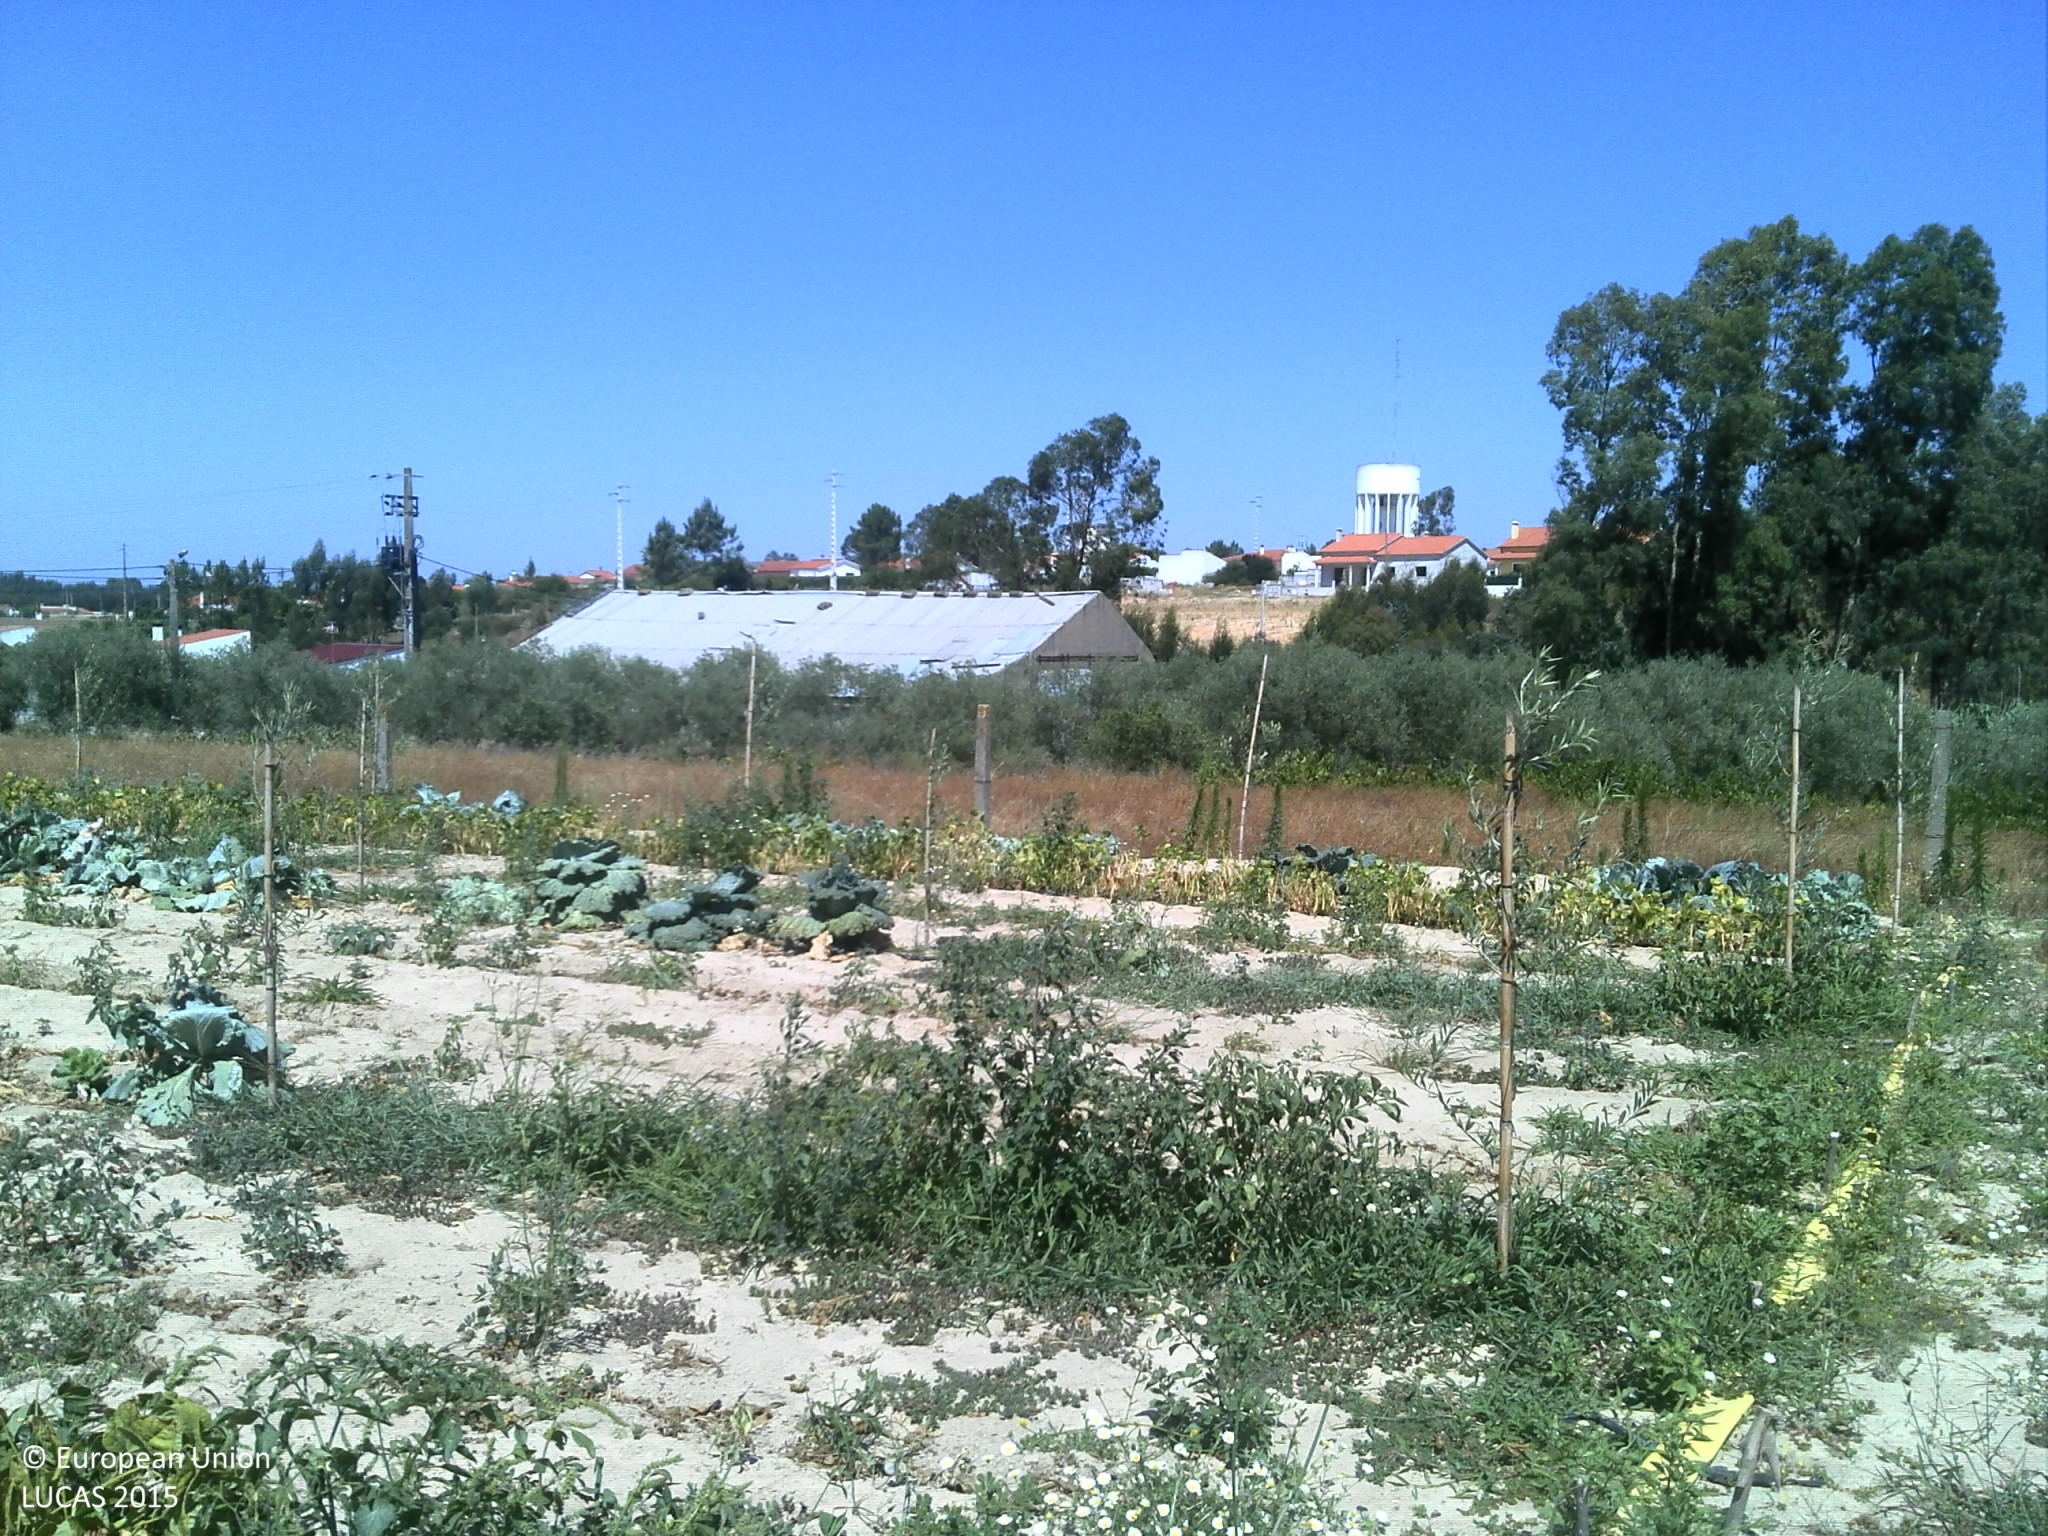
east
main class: Cropland
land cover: Oranges
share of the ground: 50 - 75 %
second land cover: Other bare soil
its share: > 75 %
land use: Agriculture (excluding fallow land and kitchen gardens)
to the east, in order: Fences; Olive groves; Other fresh vegetables; Fences; Spontaneously vegetated surfaces; Vineyards; Olive groves; Tracks; Shrubland without tree cover; Ditches and canals; Broadleaved woodland; Shrubland without tree cover; Broadleaved woodland; Artificial constructions in urban areas
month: June
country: PT
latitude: 39.0470
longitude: -8.6829
